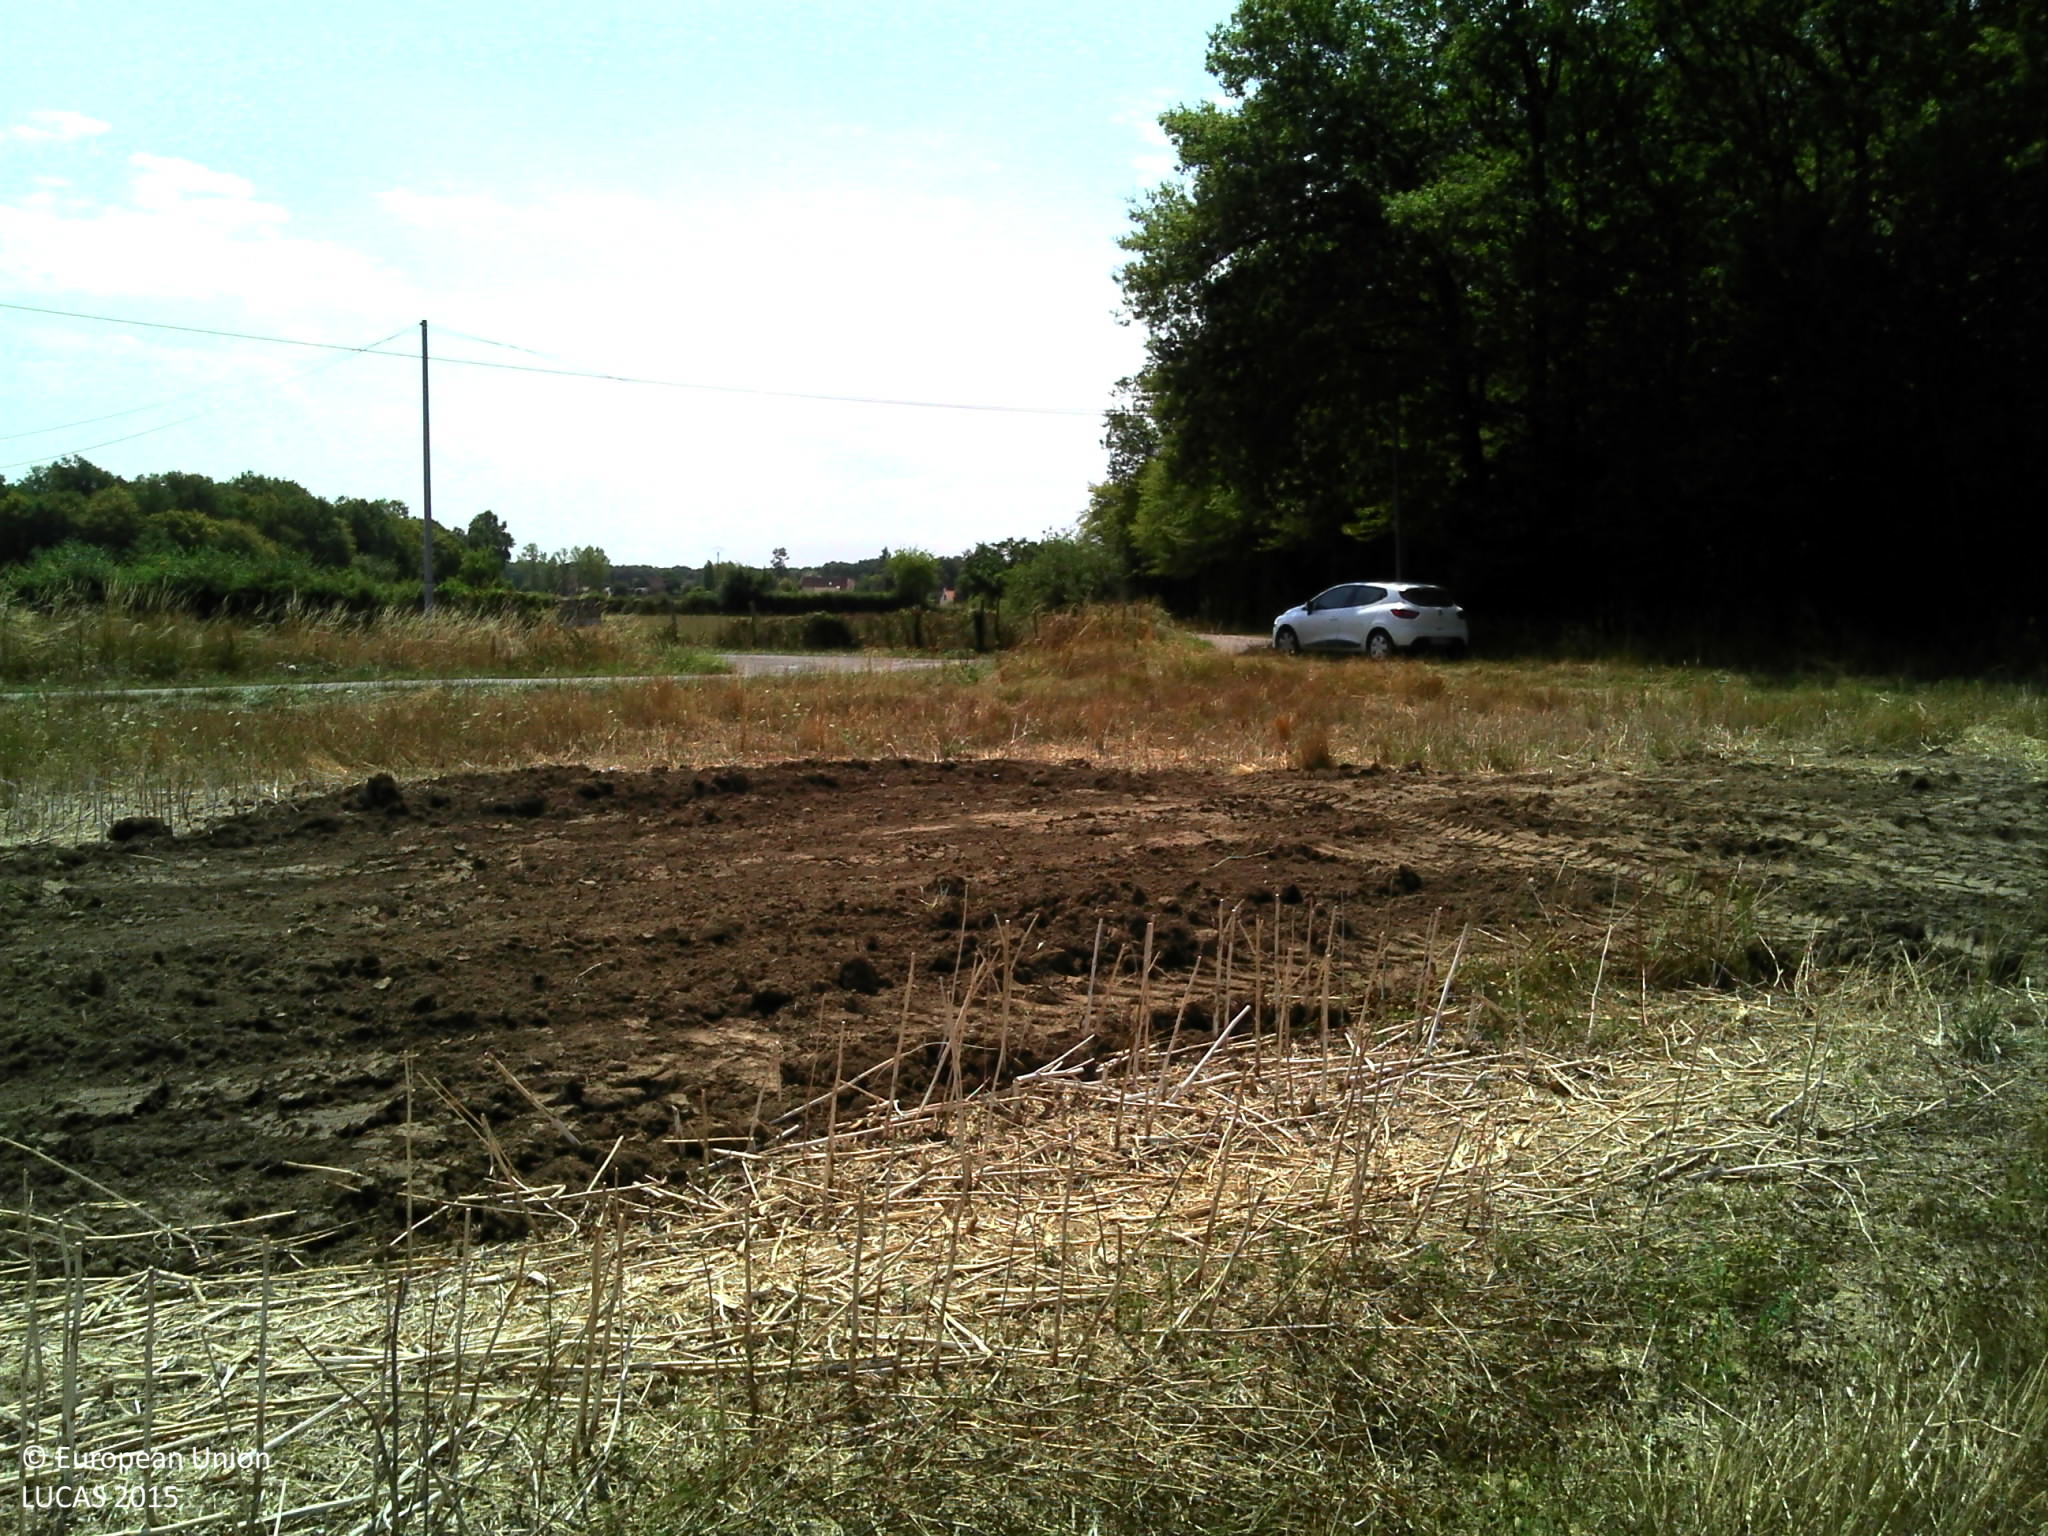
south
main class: Cropland
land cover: Rape and turnip rape
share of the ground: > 75 %
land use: Agriculture (excluding fallow land and kitchen gardens)
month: August
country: FR
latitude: 47.7543
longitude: 3.0974
